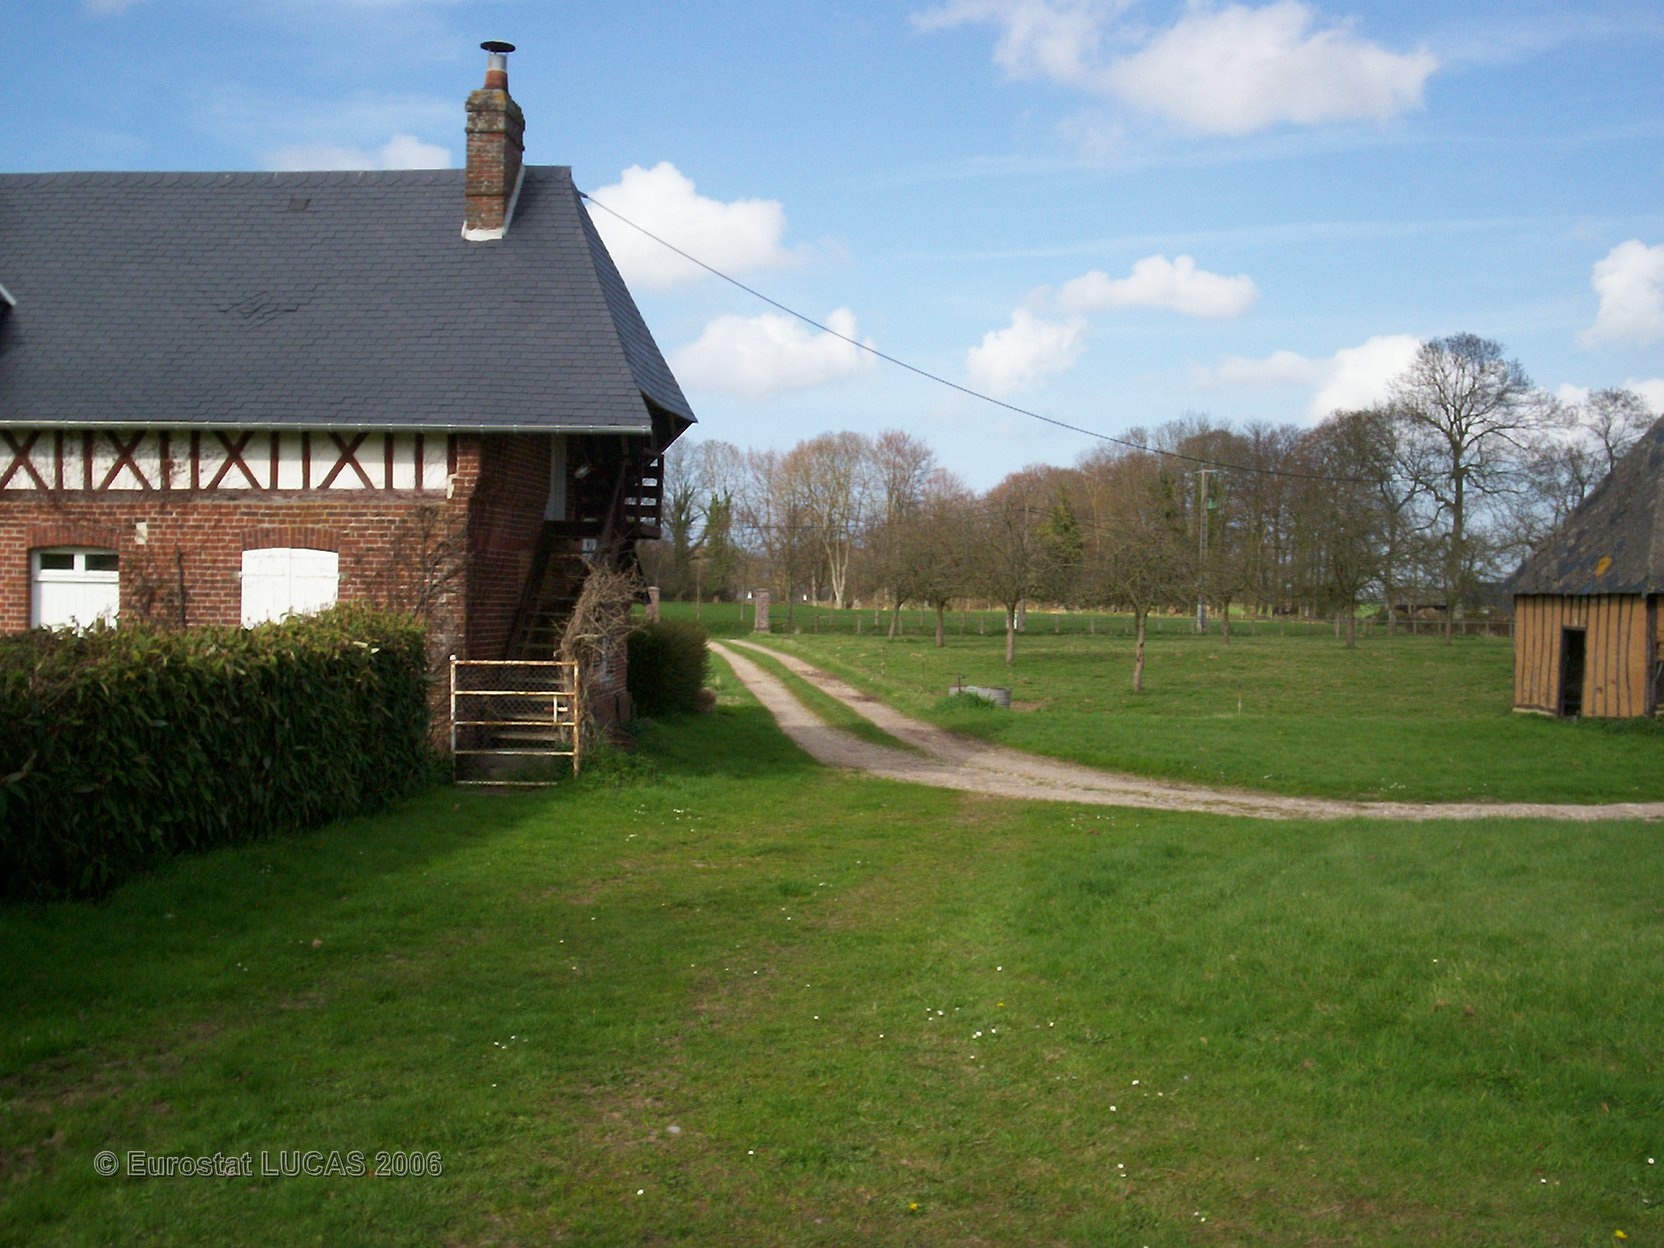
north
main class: Grassland
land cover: Grassland without tree/shrub cover
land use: Agriculture (excluding fallow land and kitchen gardens)
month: April
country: FR
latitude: 49.8308
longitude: 0.8142
